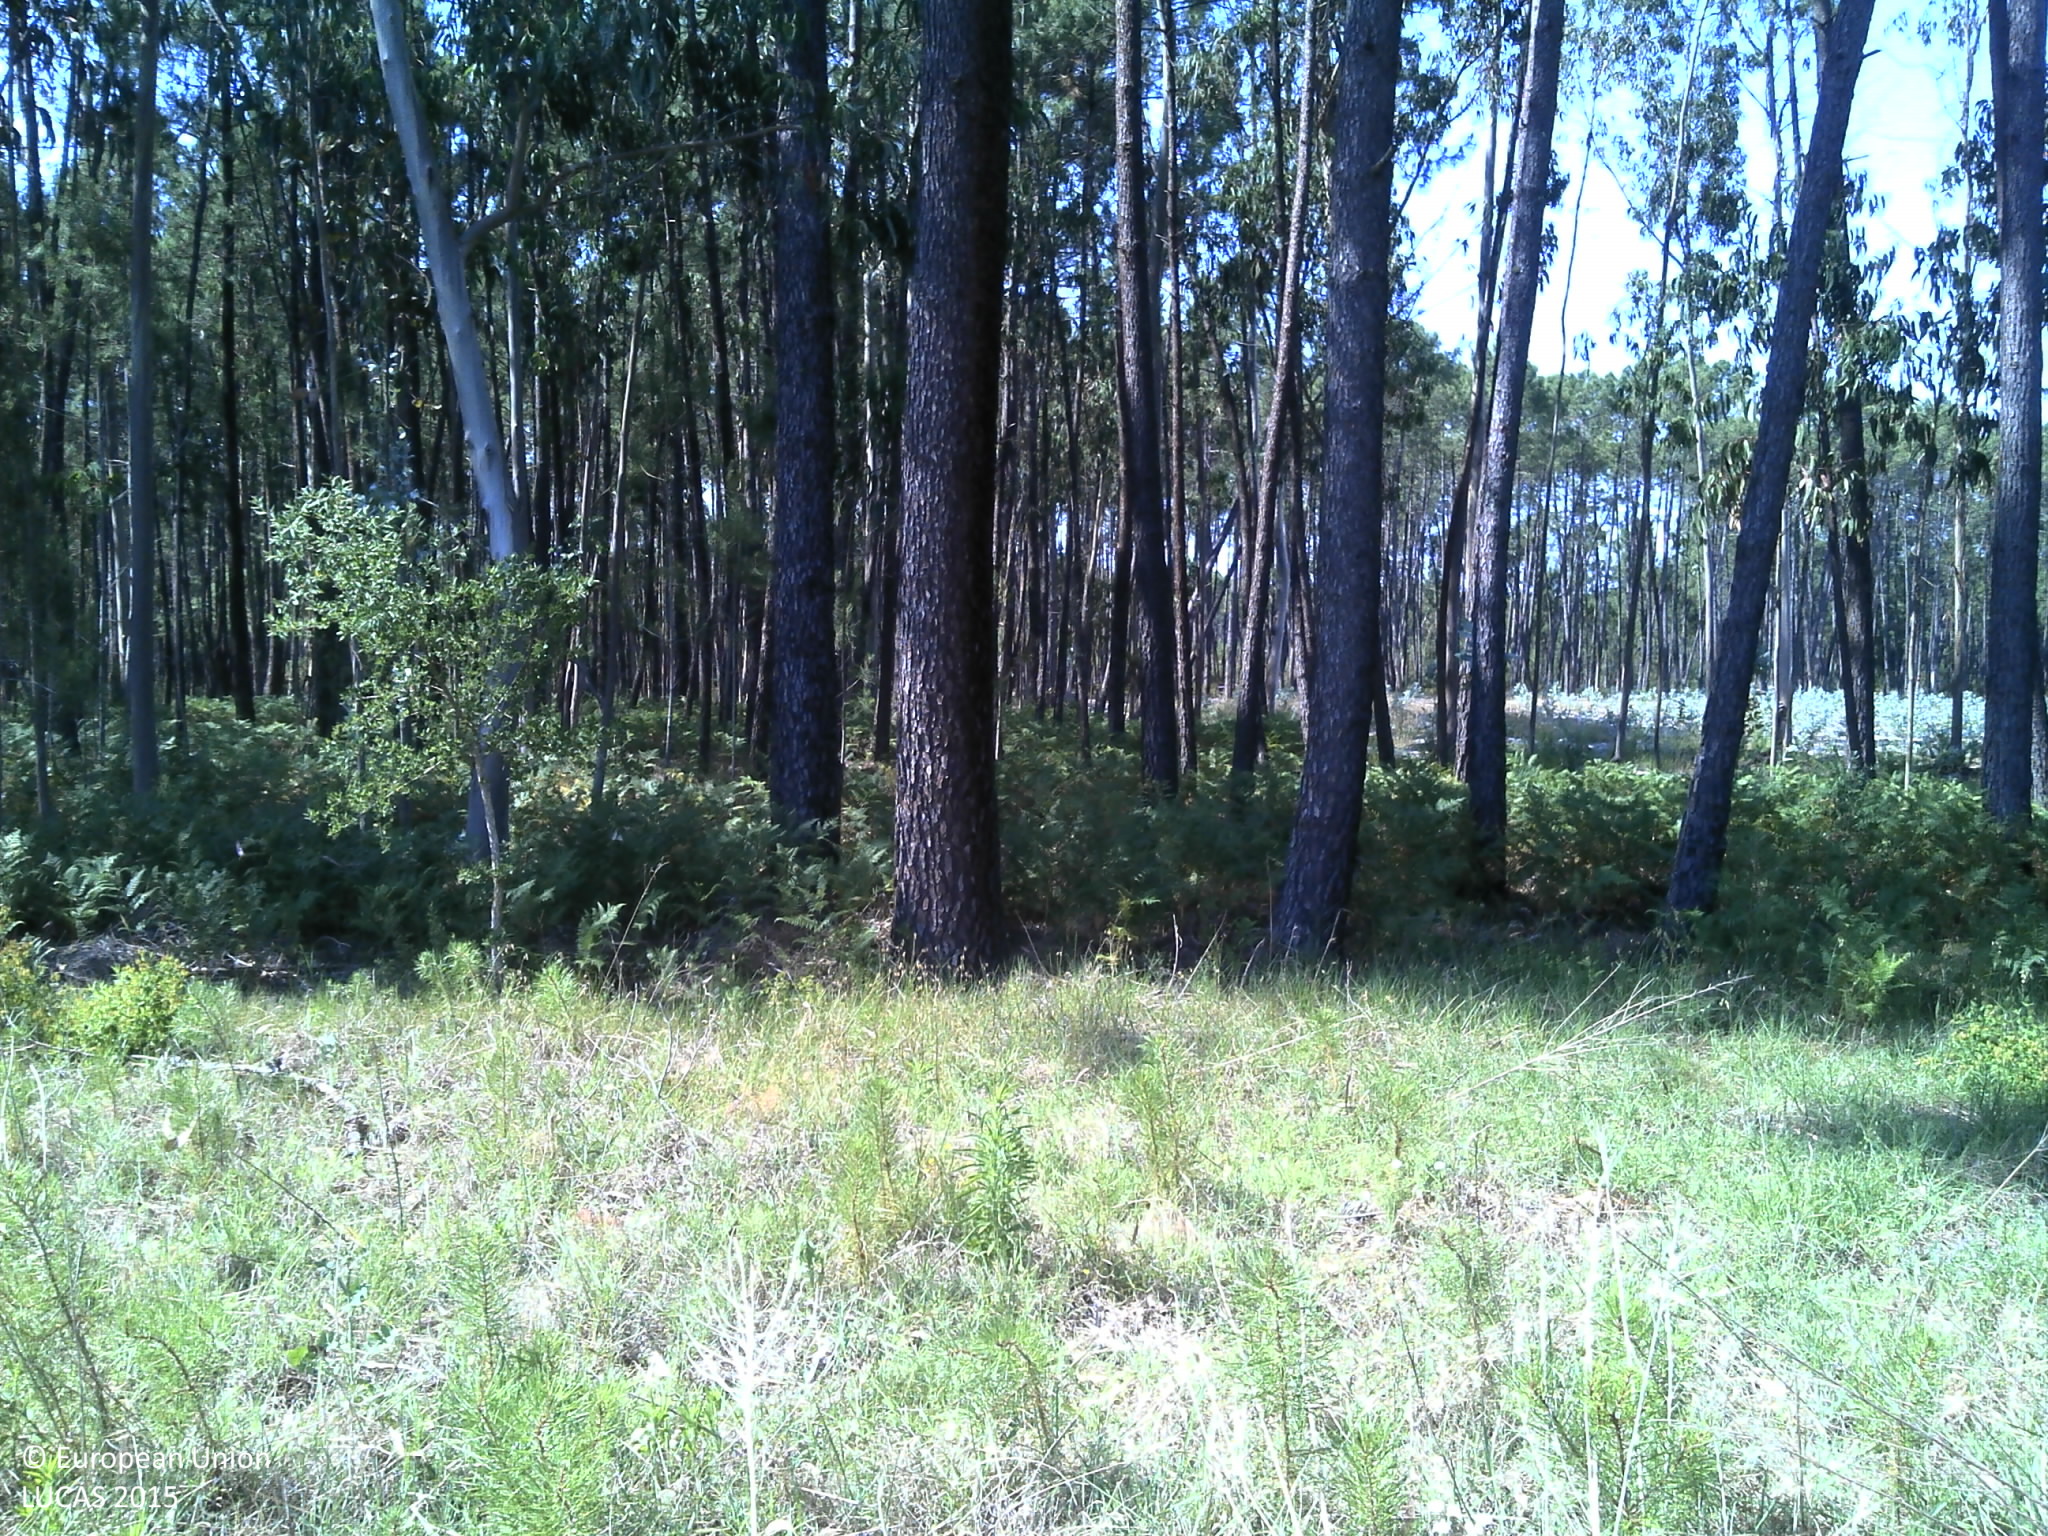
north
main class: Grassland
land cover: Spontaneously vegetated surfaces
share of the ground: 50 - 75 %
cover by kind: herbaceous plants 75 %, unconsolidated bare surface 25 %
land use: Fallow land
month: June
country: PT
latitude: 40.3469
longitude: -8.6587
